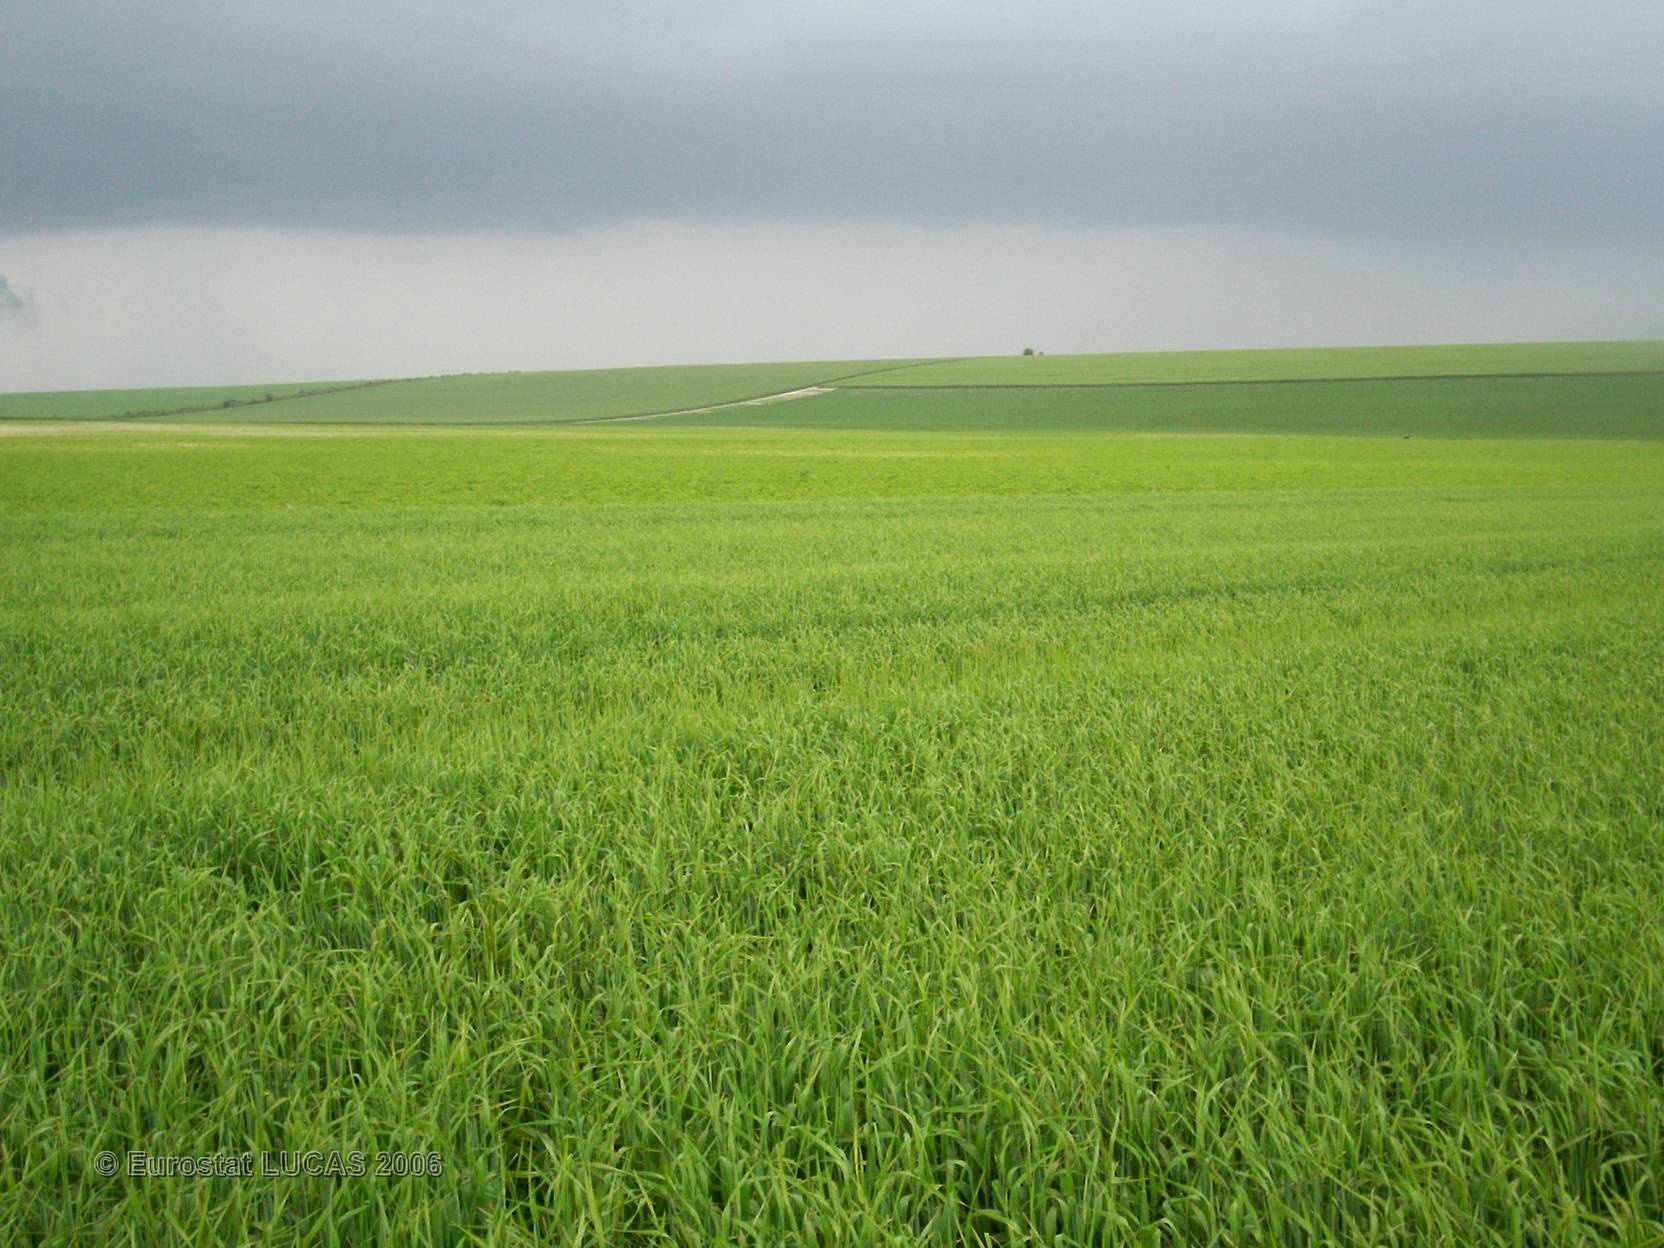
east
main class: Cropland
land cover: Barley
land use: Agriculture (excluding fallow land and kitchen gardens)
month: June
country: FR
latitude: 48.6427
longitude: 4.4460
